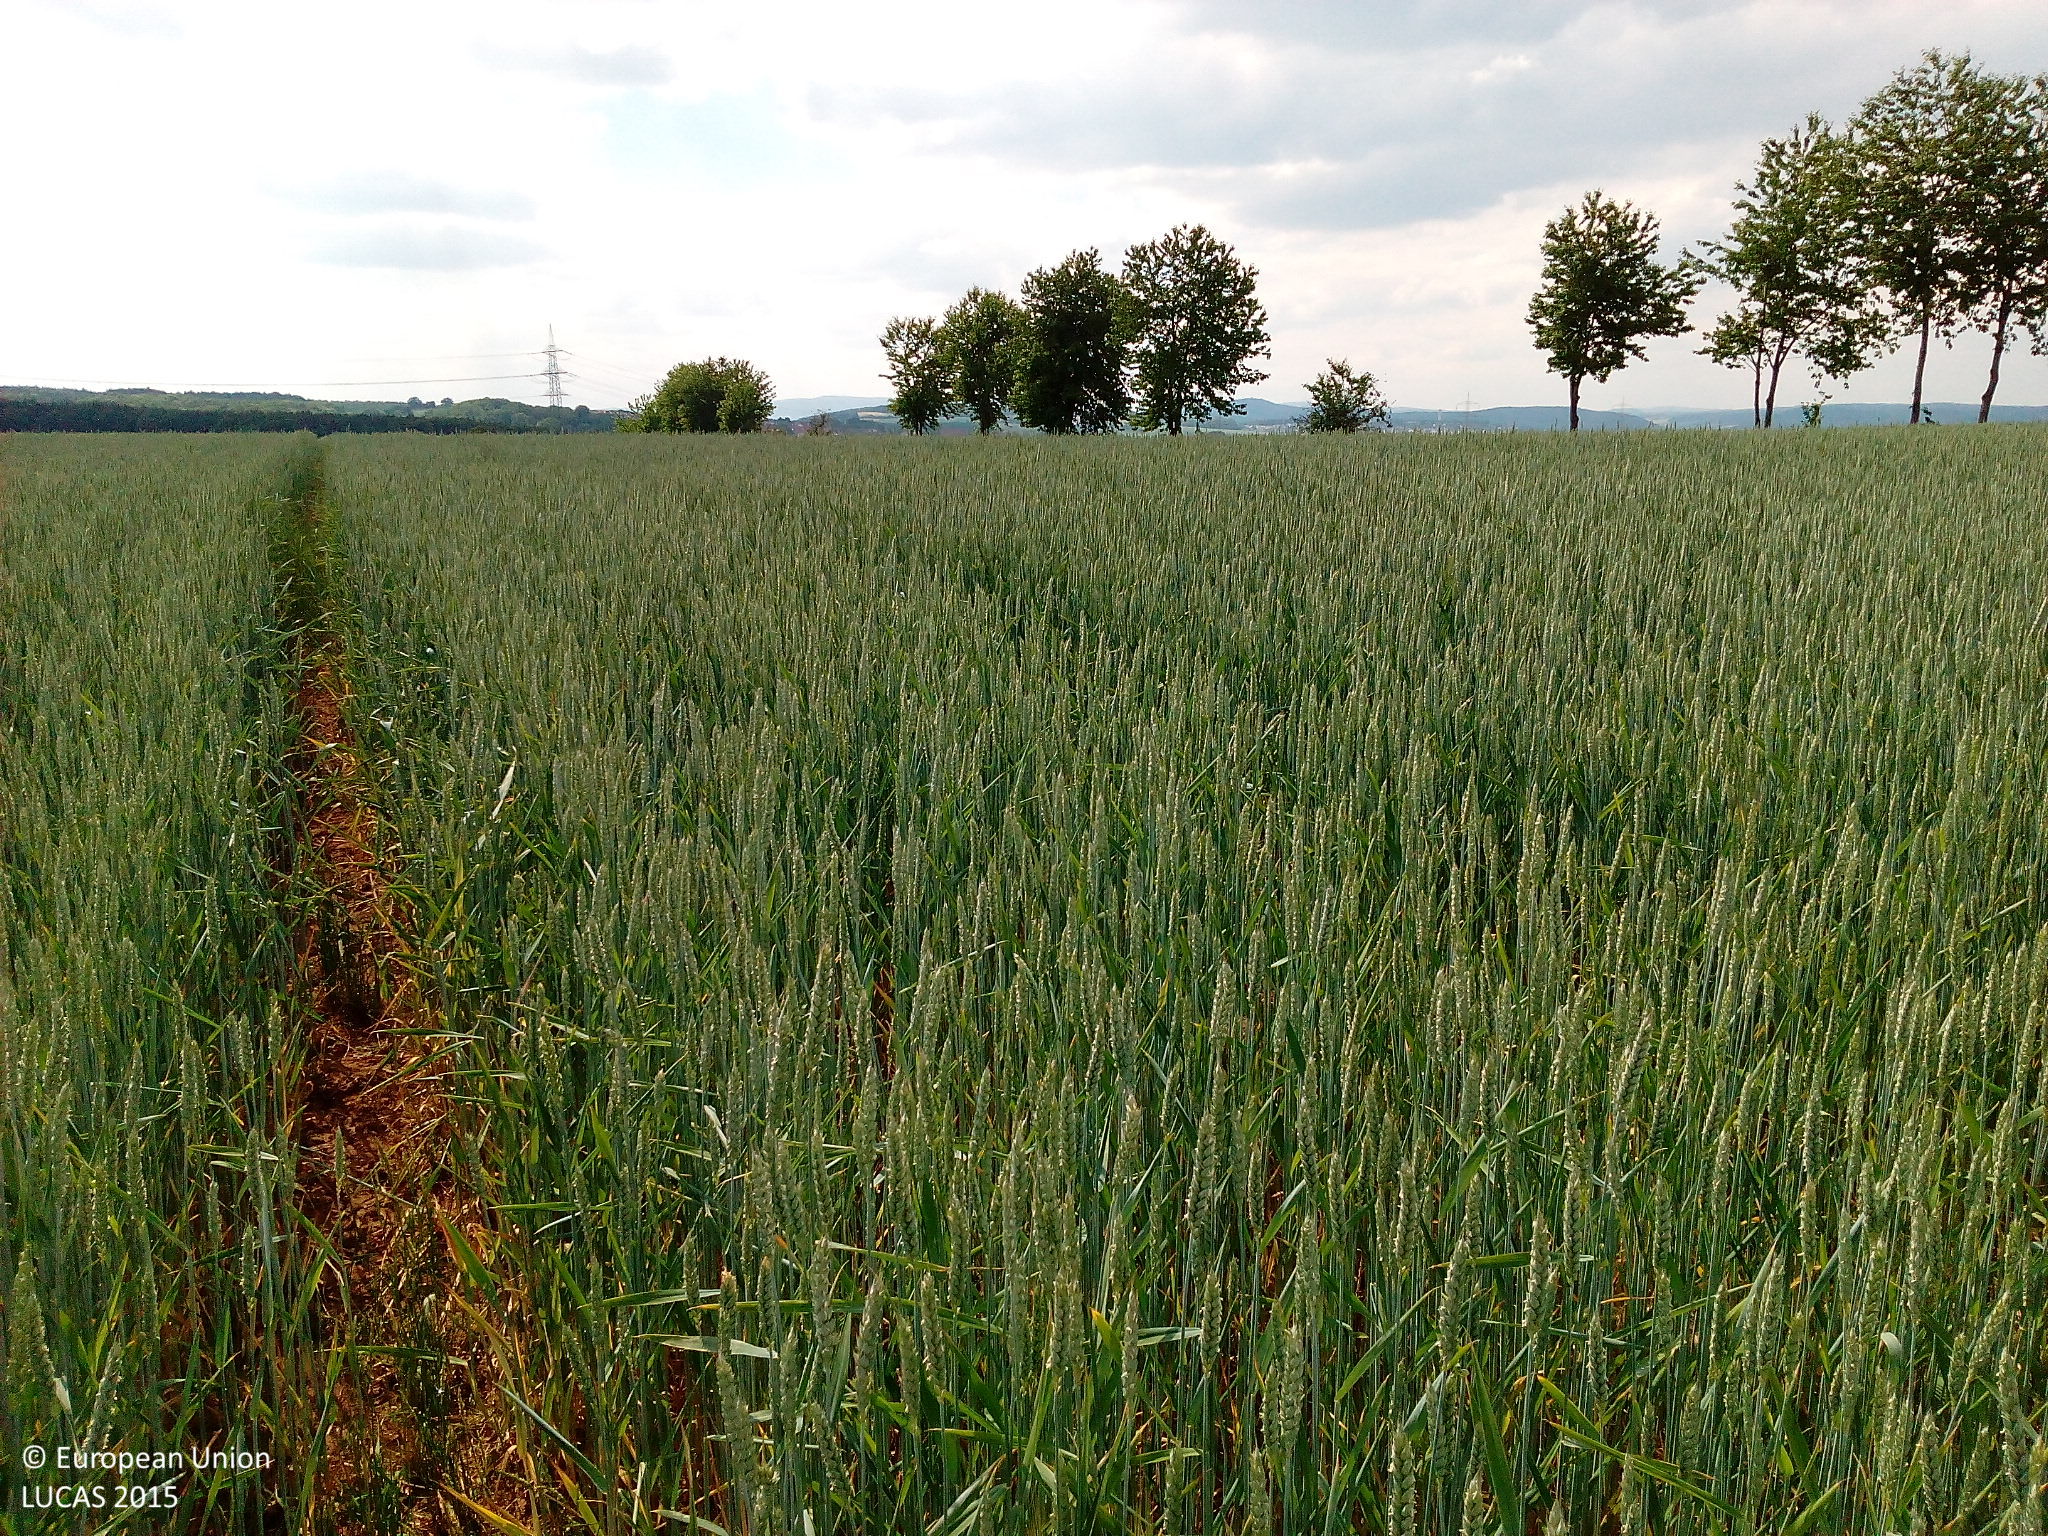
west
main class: Cropland
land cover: Common wheat
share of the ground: > 75 %
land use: Agriculture (excluding fallow land and kitchen gardens)
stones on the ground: < 10 %
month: June
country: DE
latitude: 51.0275
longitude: 9.3586
